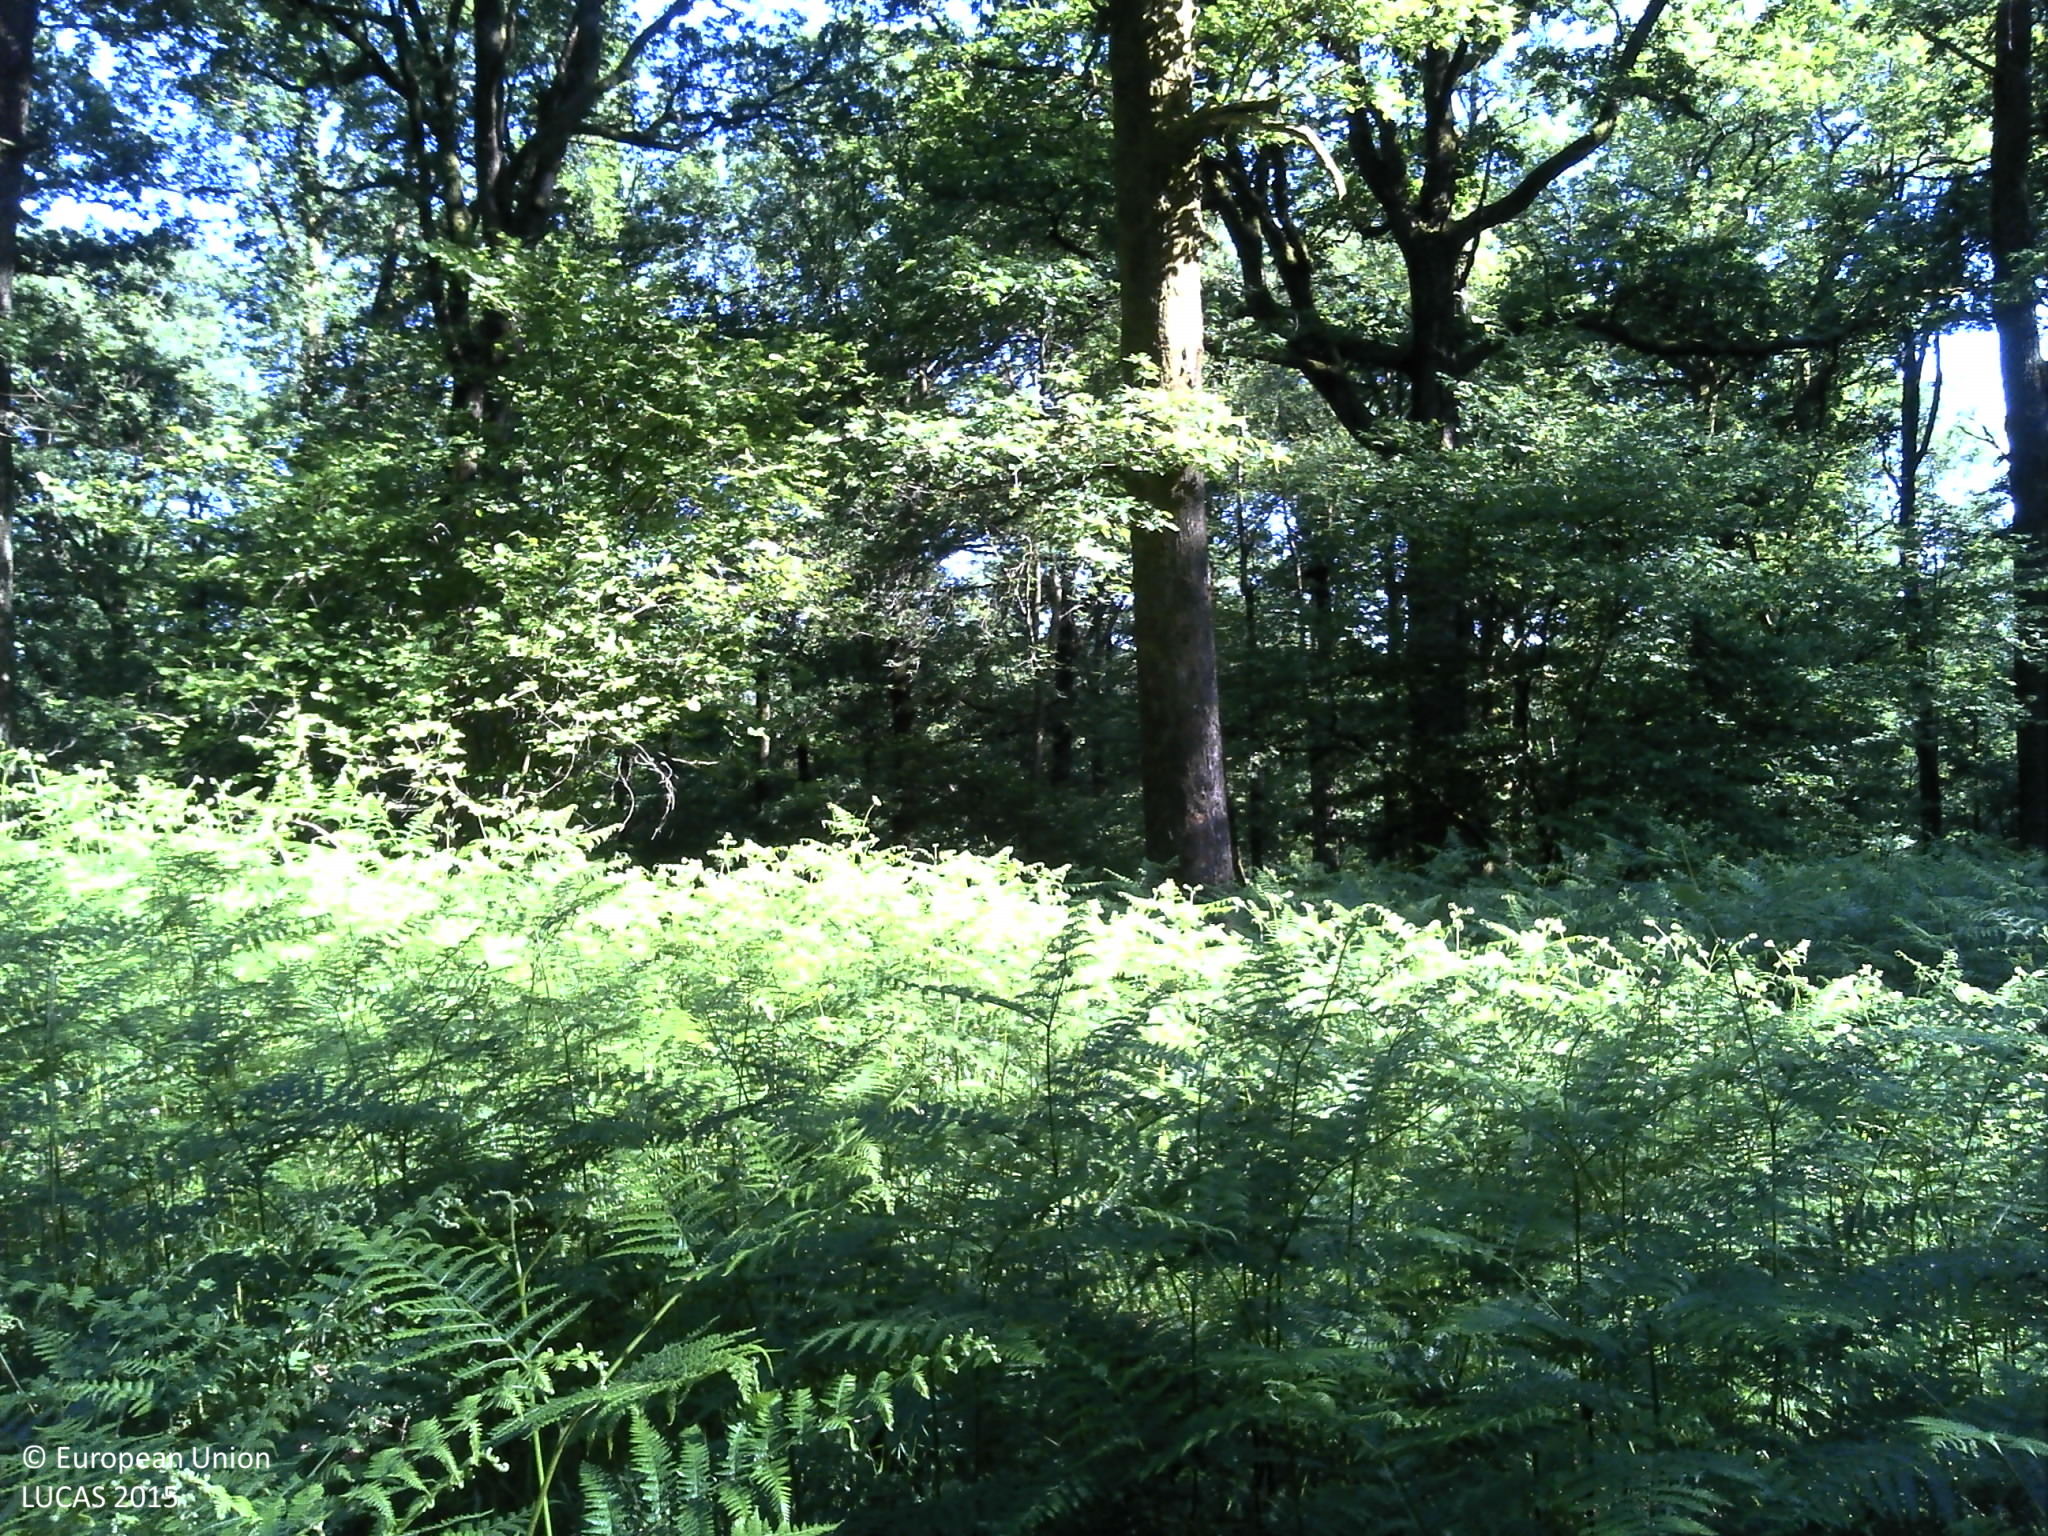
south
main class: Woodland
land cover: Broadleaved woodland
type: acidophilous oak and oak-birch forest
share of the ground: 50 - 75 %
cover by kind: broadleaved forest trees 60 %, herbaceous plants 35 %, lichens and mosses 5 %
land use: Forestry
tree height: > 5 m
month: June
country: FR
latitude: 49.9549
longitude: 4.7420
